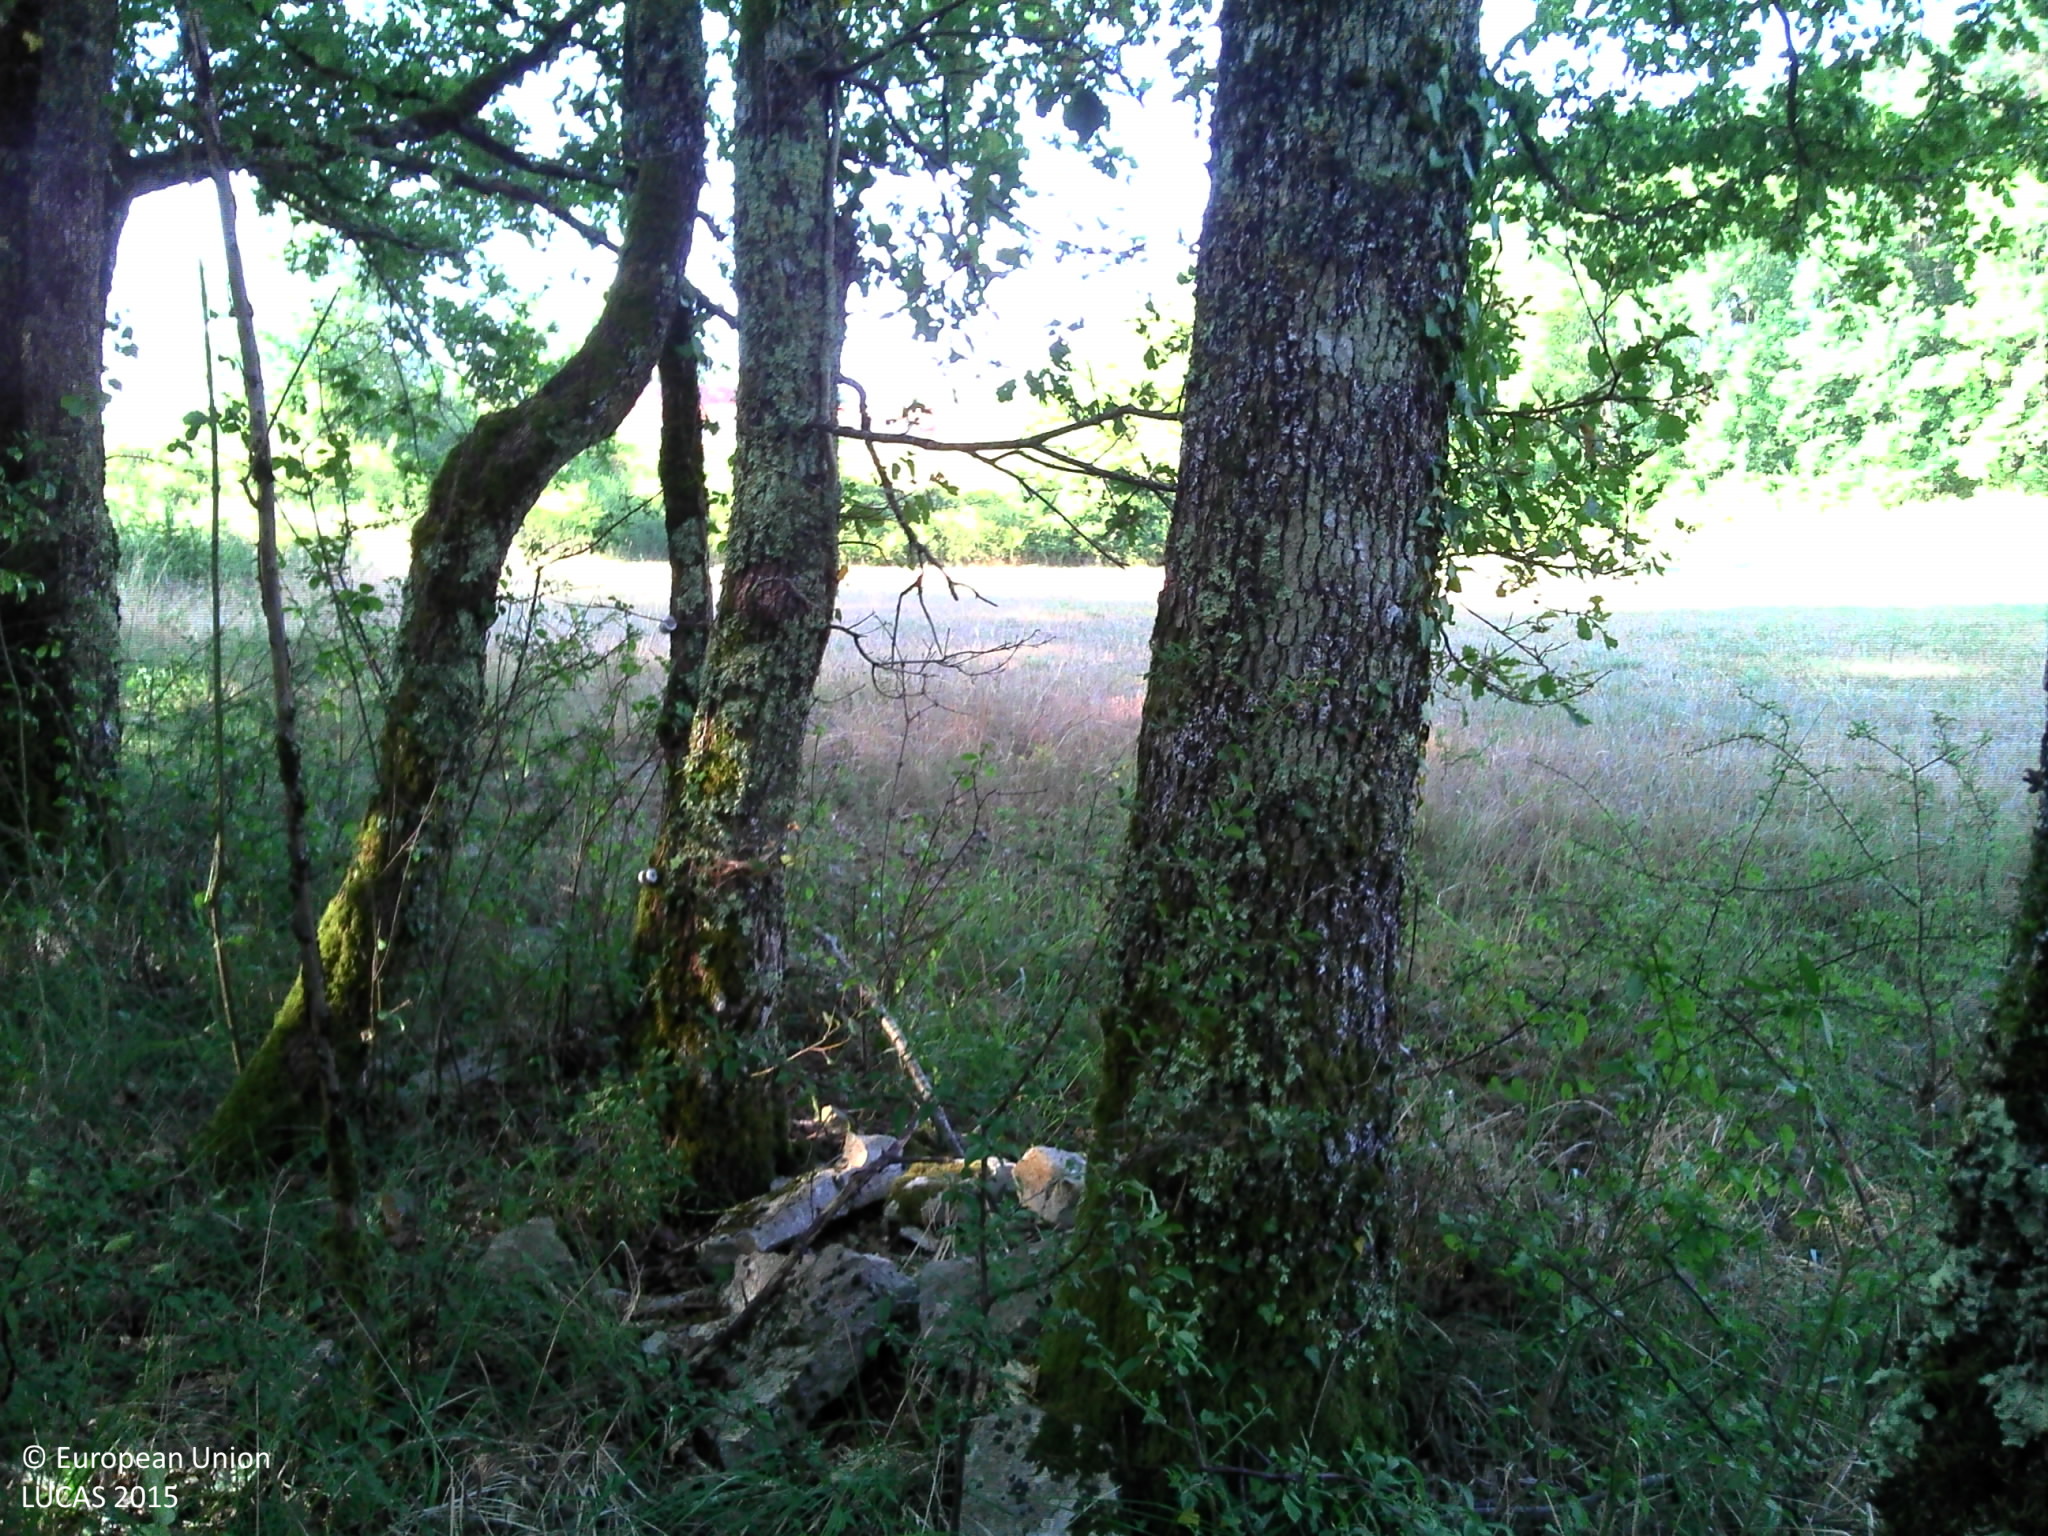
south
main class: Woodland
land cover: Broadleaved woodland
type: acidophilous oak and oak-birch forest
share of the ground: > 75 %
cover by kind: broadleaved forest trees 75 %, herbaceous plants 15 %, coniferous forest trees 5 %, shrubs 5 %
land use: Forestry
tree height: > 5 m
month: July
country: FR
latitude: 45.2514
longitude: 1.0602
